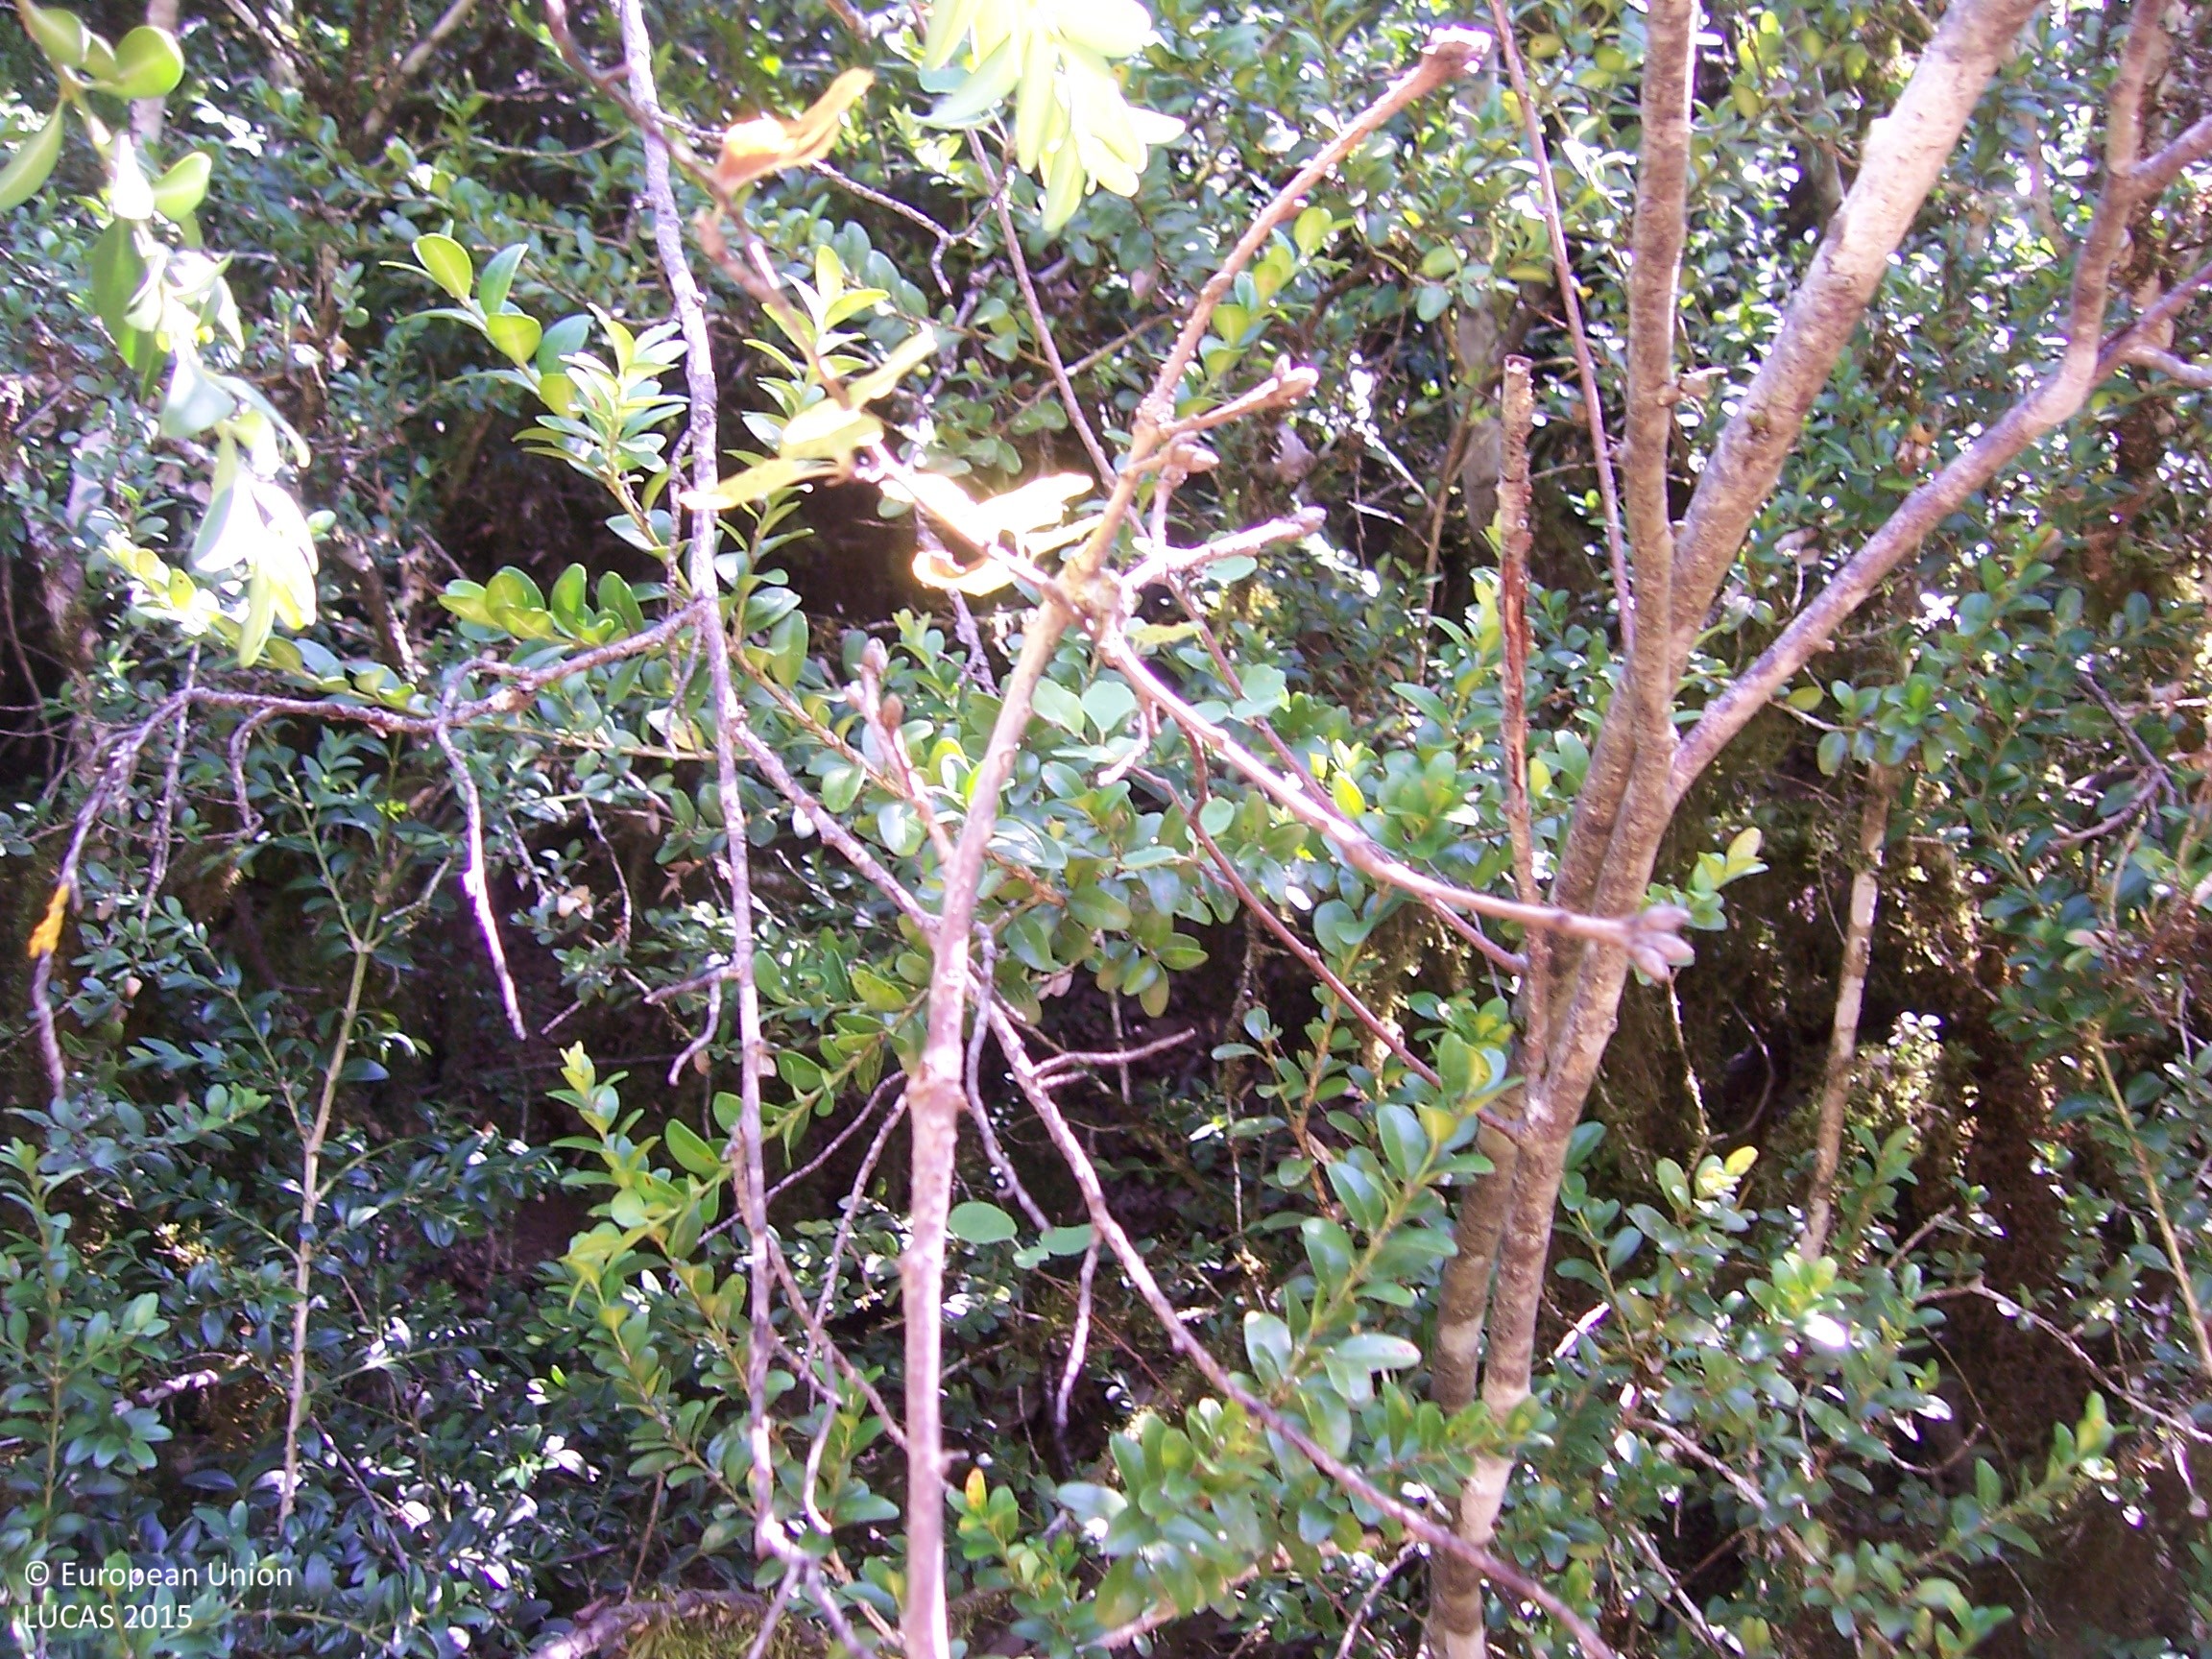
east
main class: Woodland
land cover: Broadleaved woodland
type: mountainous beech forest
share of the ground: > 75 %
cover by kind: broadleaved forest trees 100 %
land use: Semi-natural and natural areas not in use
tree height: > 5 m
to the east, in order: Broadleaved woodland; Pine dominated coniferous woodland; Grassland without tree/shrub cover; Pine dominated coniferous woodland
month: August
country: ES
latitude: 42.6200
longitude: -0.1070
